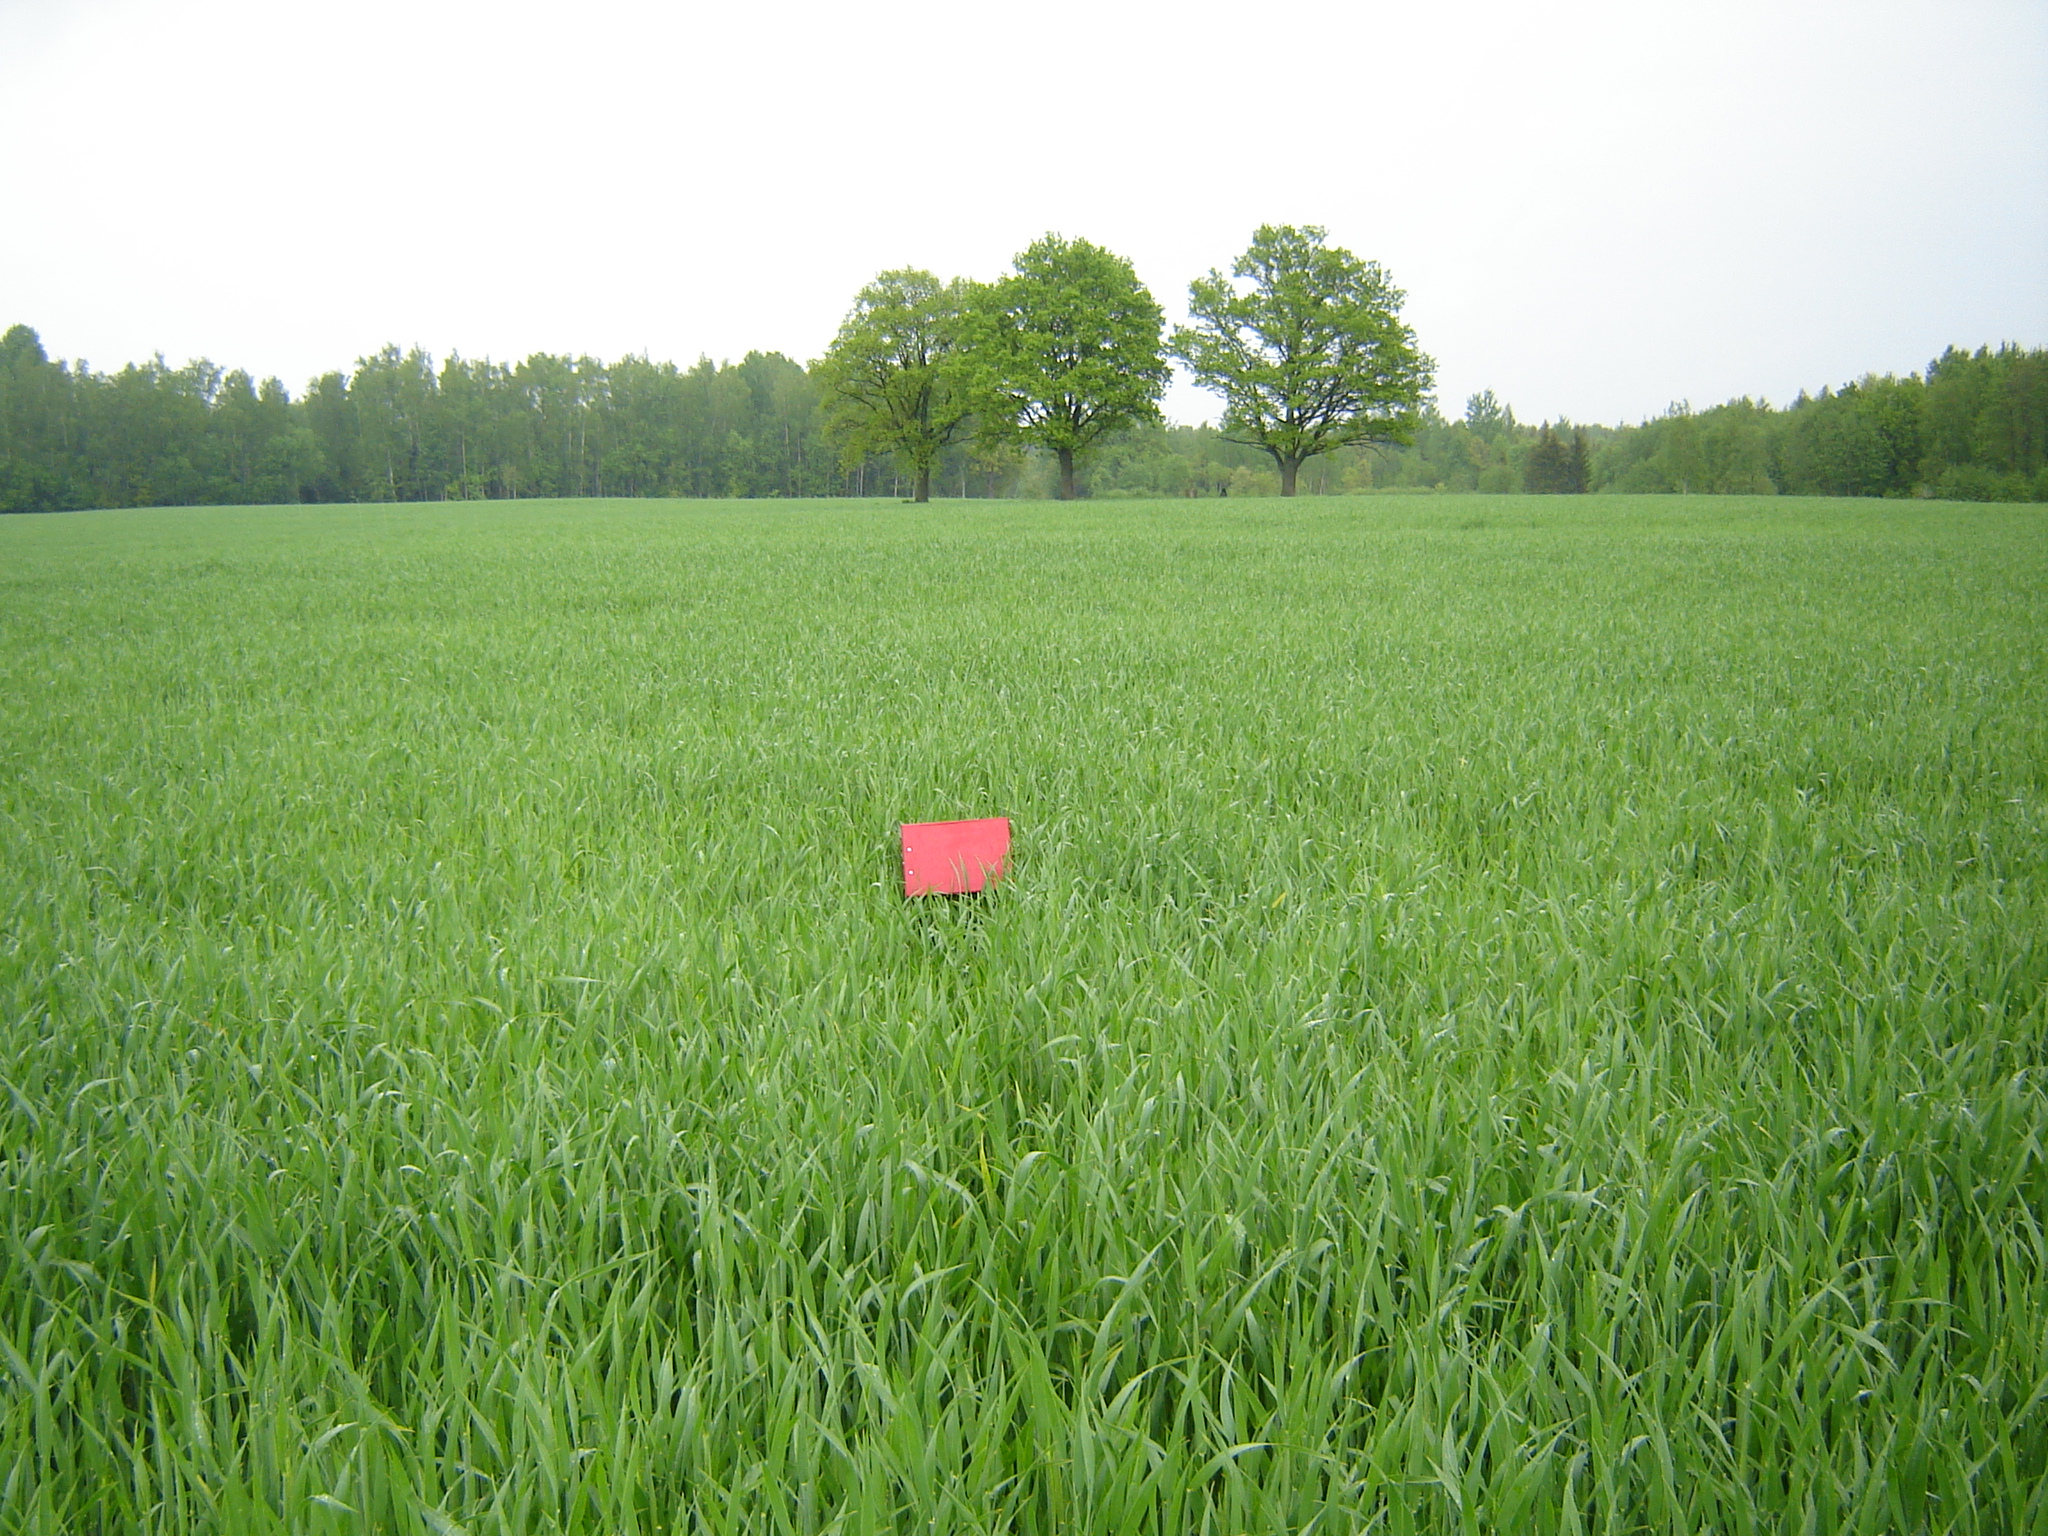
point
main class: Cropland
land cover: Common wheat
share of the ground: > 75 %
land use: Agriculture (excluding fallow land and kitchen gardens)
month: May
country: LT
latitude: 55.9296
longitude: 25.2414
